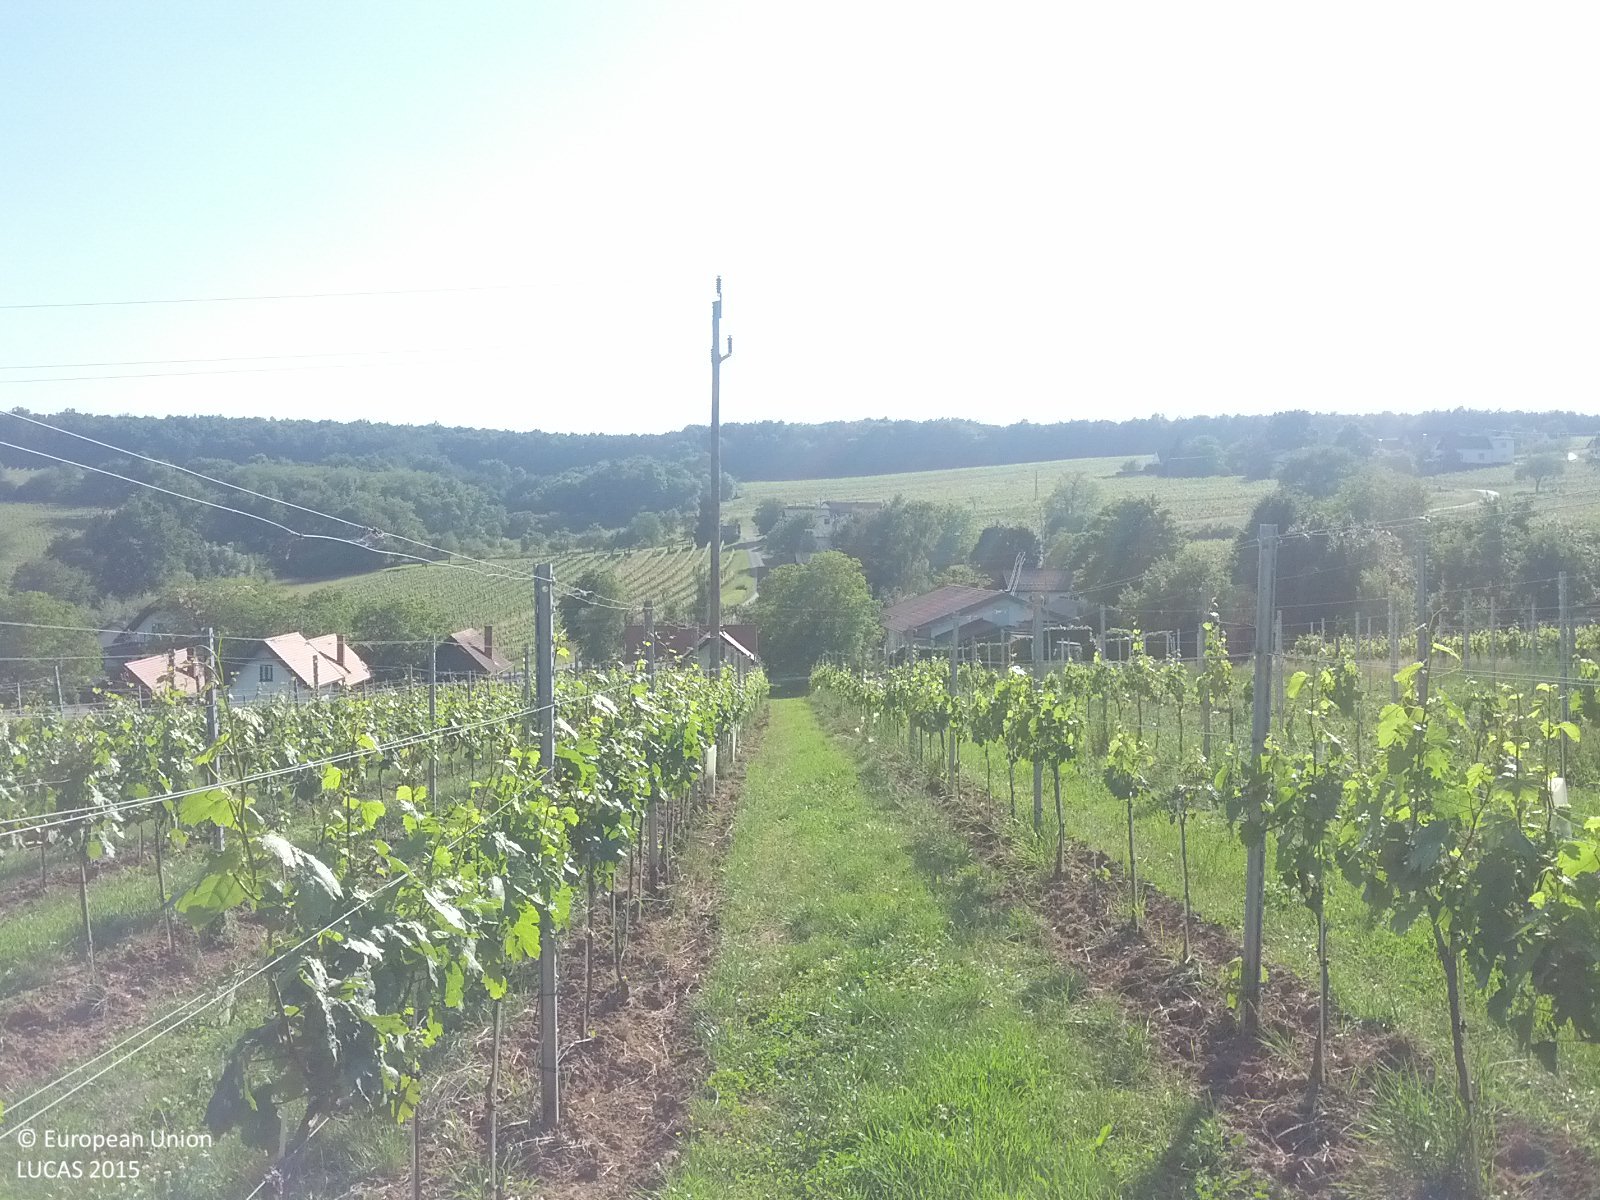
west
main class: Cropland
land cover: Vineyards
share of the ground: 50 - 75 %
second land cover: Grassland without tree/shrub cover
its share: > 75 %
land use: Agriculture (excluding fallow land and kitchen gardens)
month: June
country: AT
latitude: 47.1693
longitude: 16.4276
